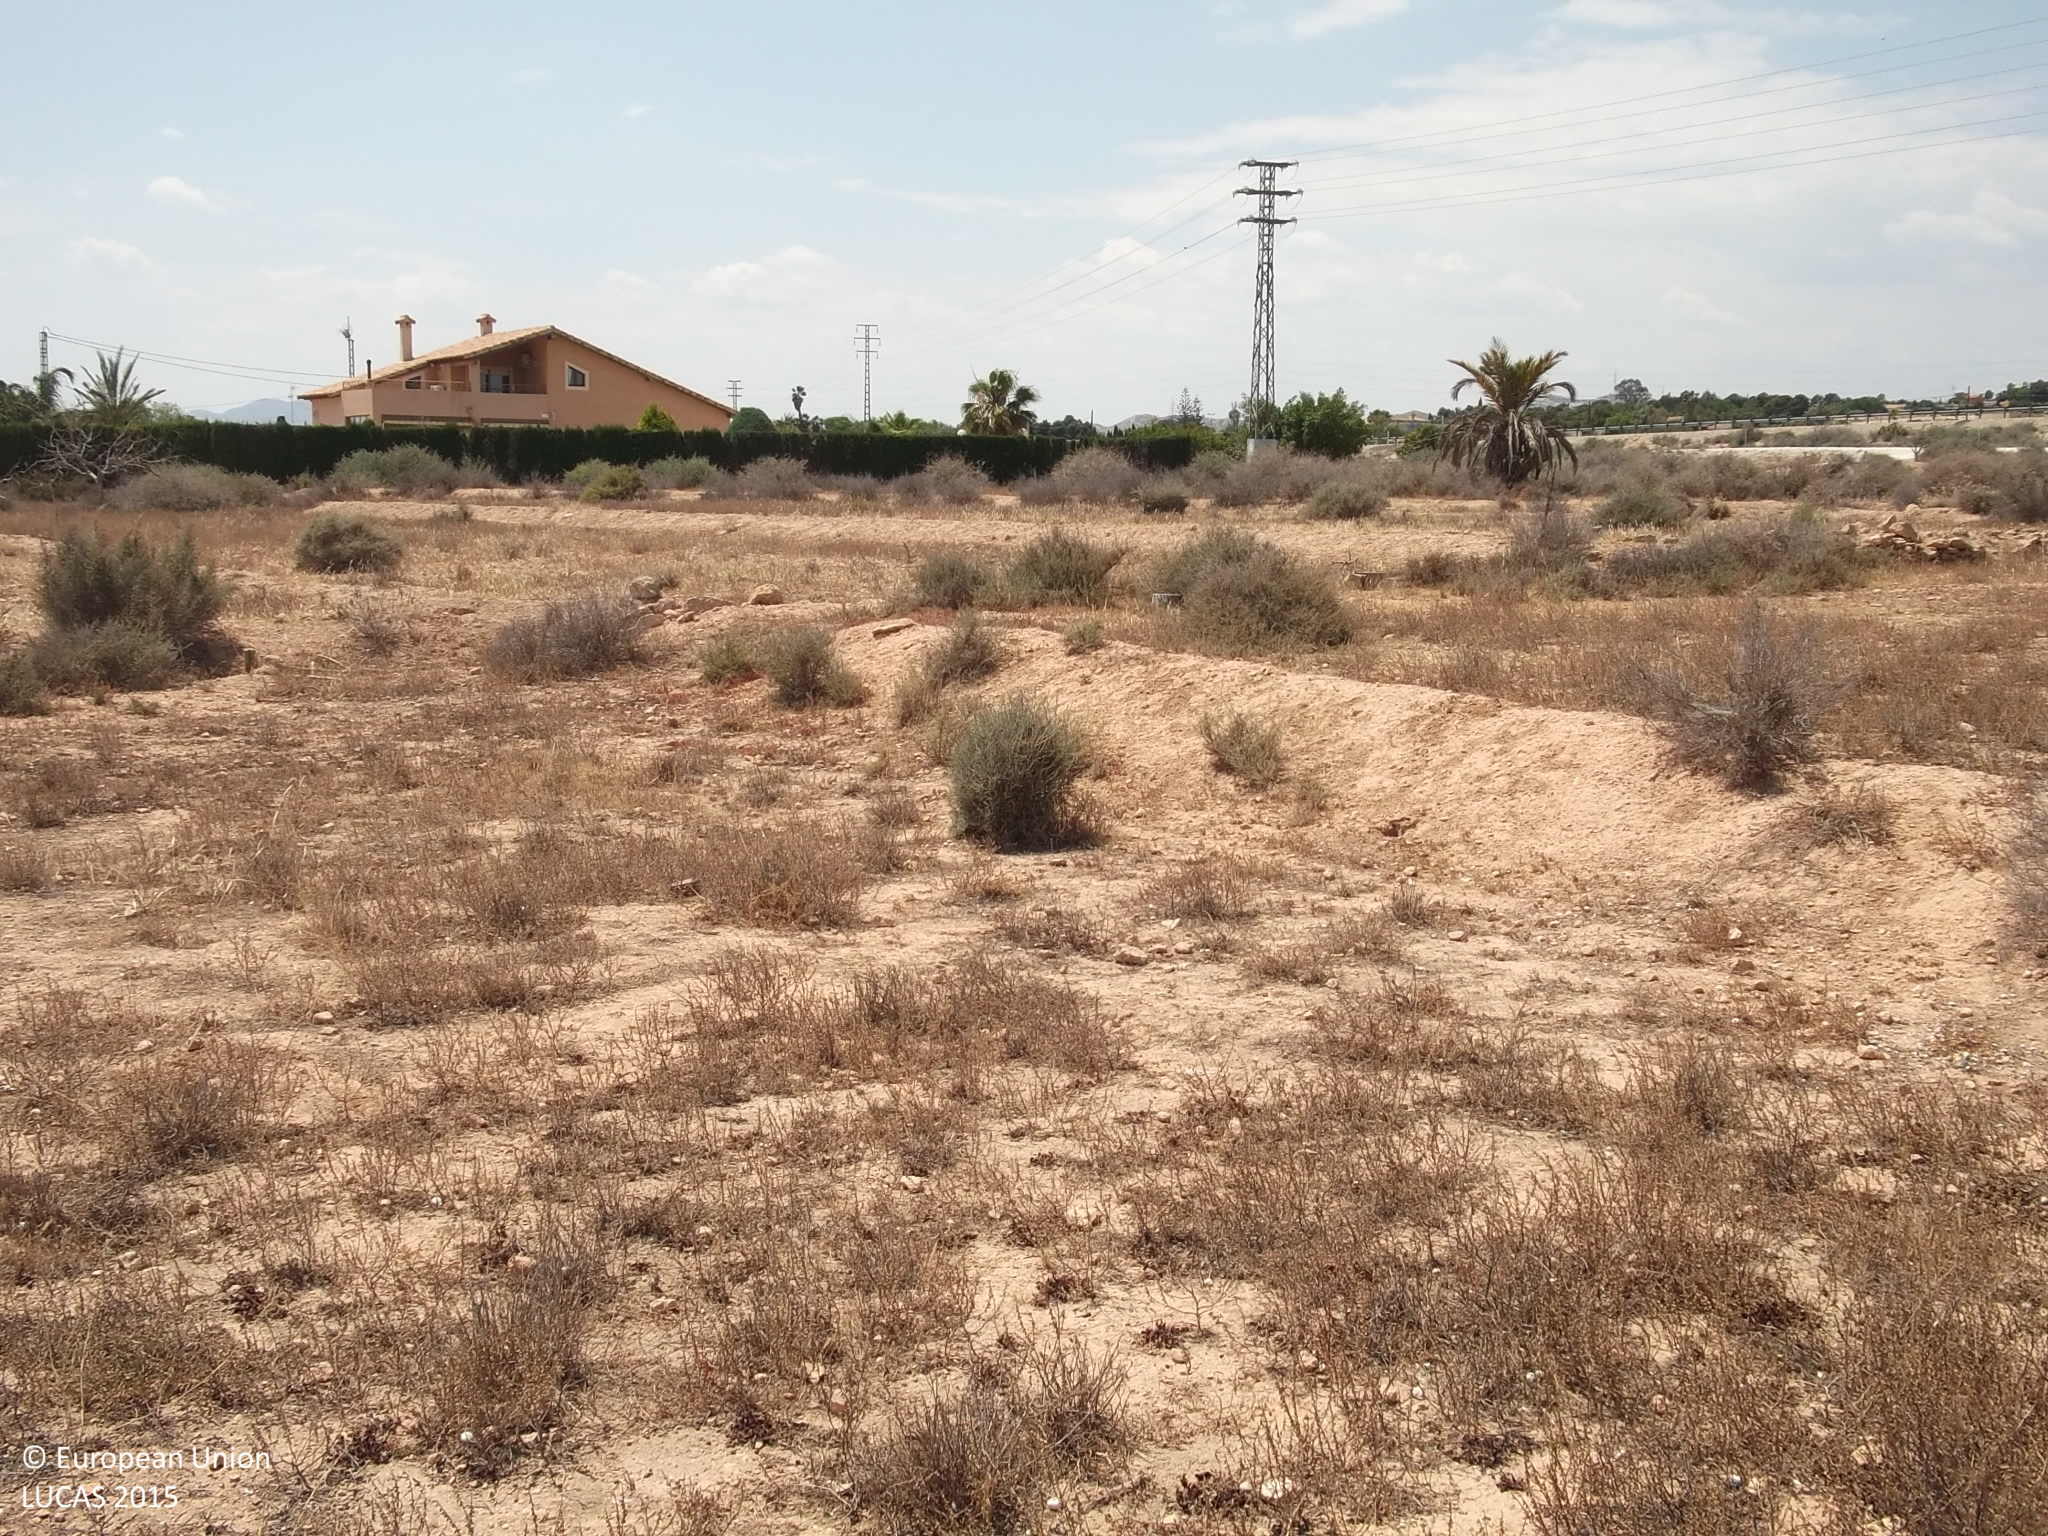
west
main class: Grassland
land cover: Grassland without tree/shrub cover
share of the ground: 50 - 75 %
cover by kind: herbaceous plants 60 %, unconsolidated bare surface 40 %
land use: Abandoned areas
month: May
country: ES
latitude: 38.3010
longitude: -0.6314
